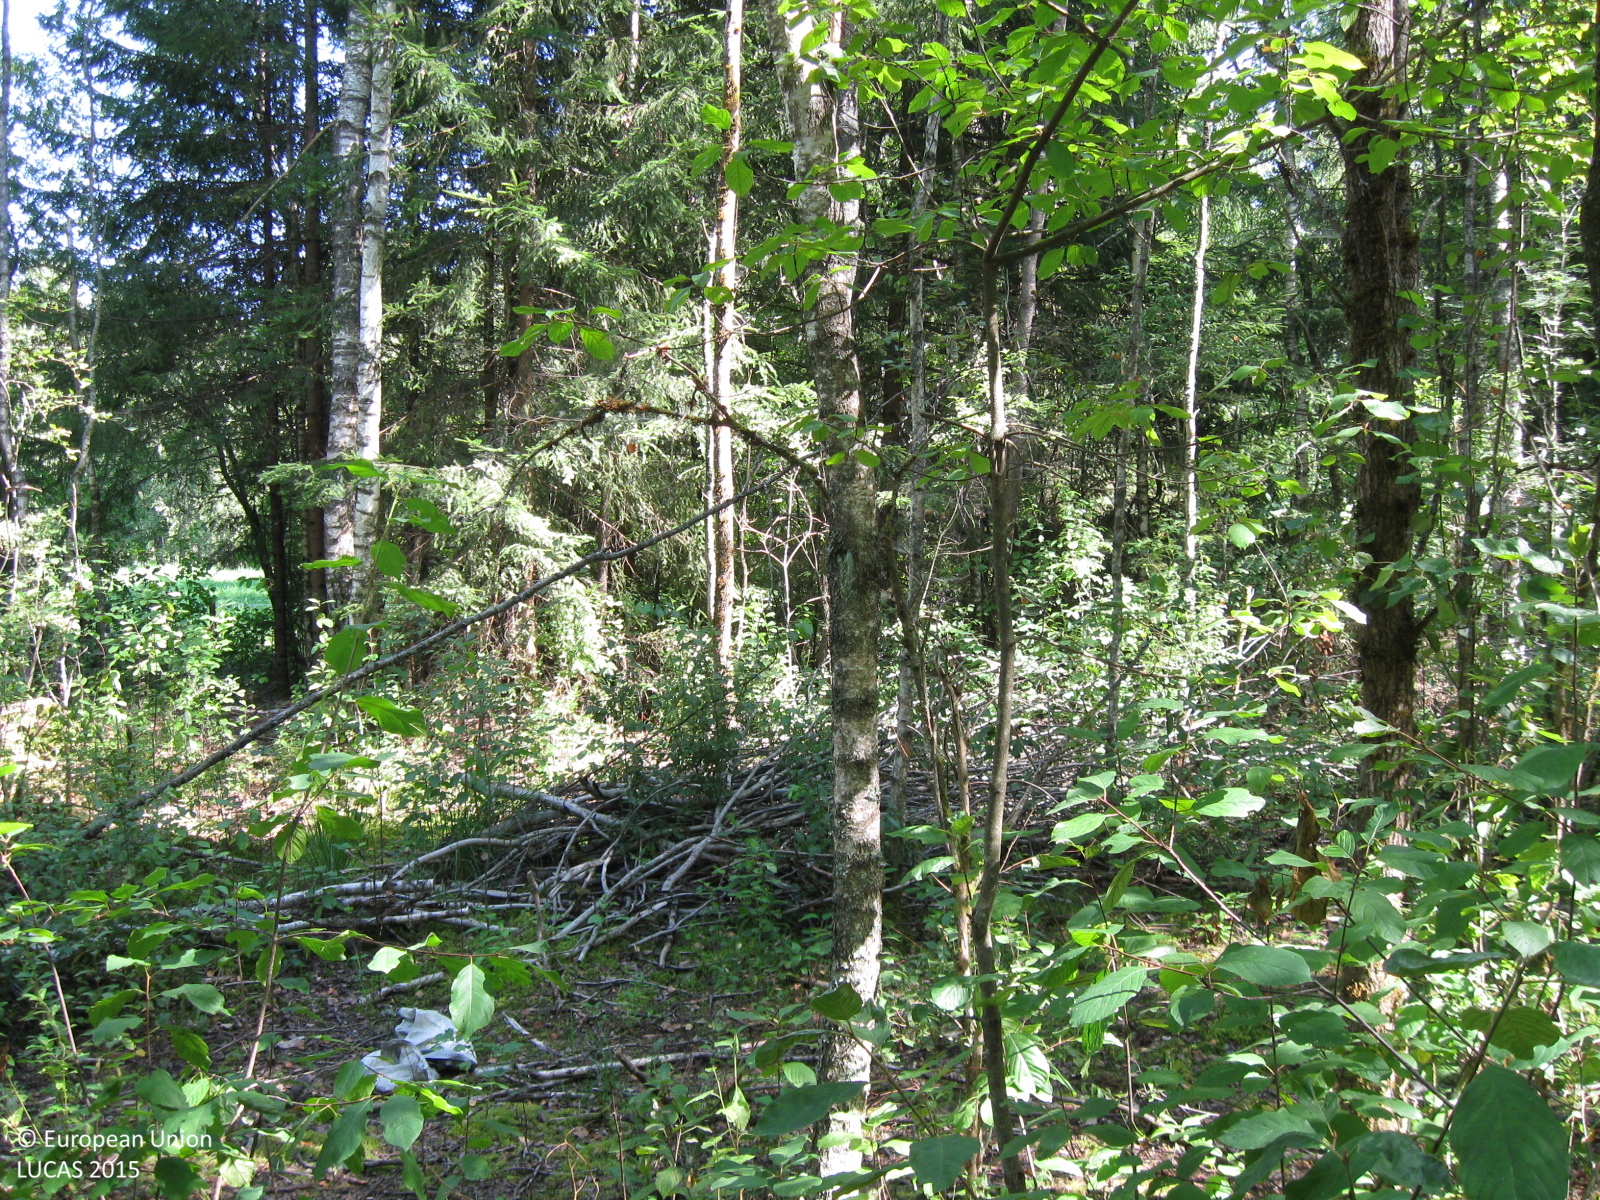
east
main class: Woodland
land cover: Other mixed woodland
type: hemiboreal forest and nemoral coniferous forest and mixed broadleaved-coniferous forest
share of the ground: > 75 %
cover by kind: broadleaved forest trees 65 %, coniferous forest trees 30 %, herbaceous plants 5 %
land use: Forestry
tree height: > 5 m
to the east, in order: Other mixed woodland; Fences; Other mixed woodland; Broadleaved woodland; Spruce dominated mixed woodland; Fences; Shruby margins; Oats
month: August
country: LT
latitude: 55.5838
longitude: 22.5791
